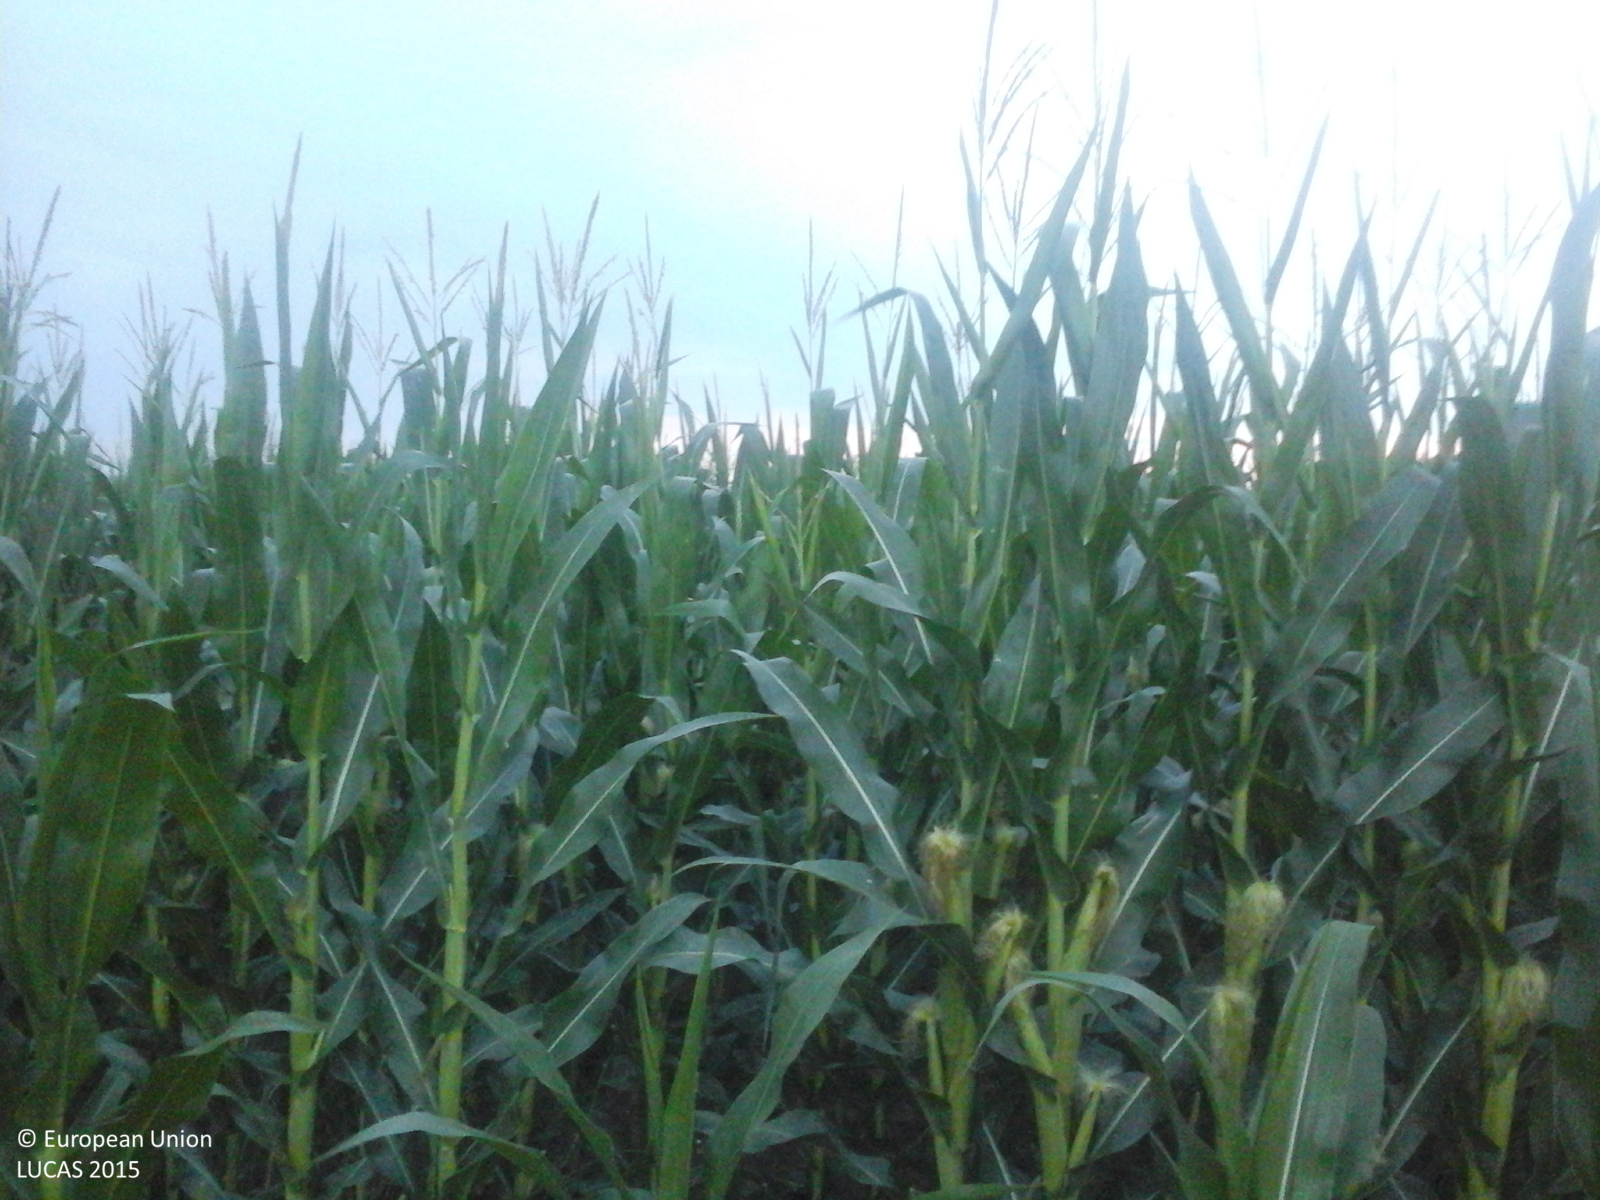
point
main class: Cropland
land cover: Maize
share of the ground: > 75 %
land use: Agriculture (excluding fallow land and kitchen gardens)
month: July
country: RO
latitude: 44.0910
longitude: 24.2641
